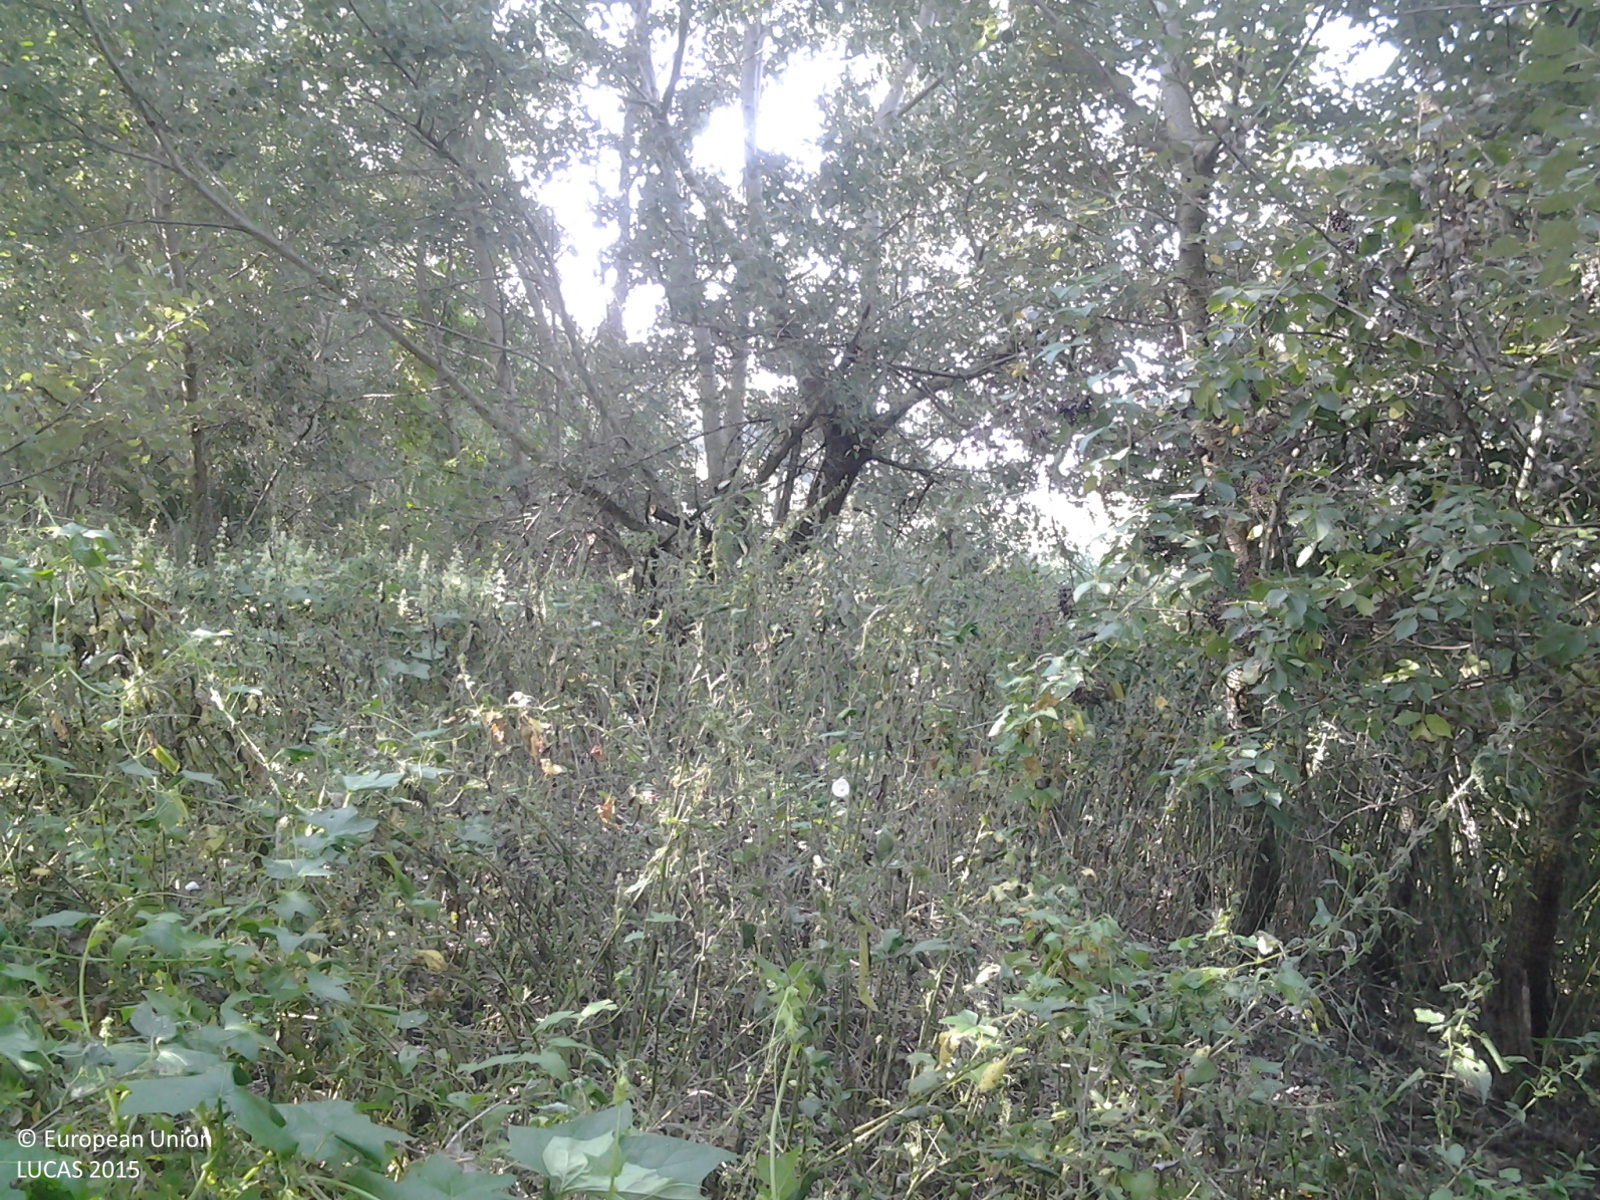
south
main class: Woodland
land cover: Broadleaved woodland
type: floodplain forest
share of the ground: > 75 %
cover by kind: broadleaved forest trees 95 %, herbaceous plants 5 %
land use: Forestry
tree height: > 5 m
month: August
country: HU
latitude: 46.4386
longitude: 18.1427
